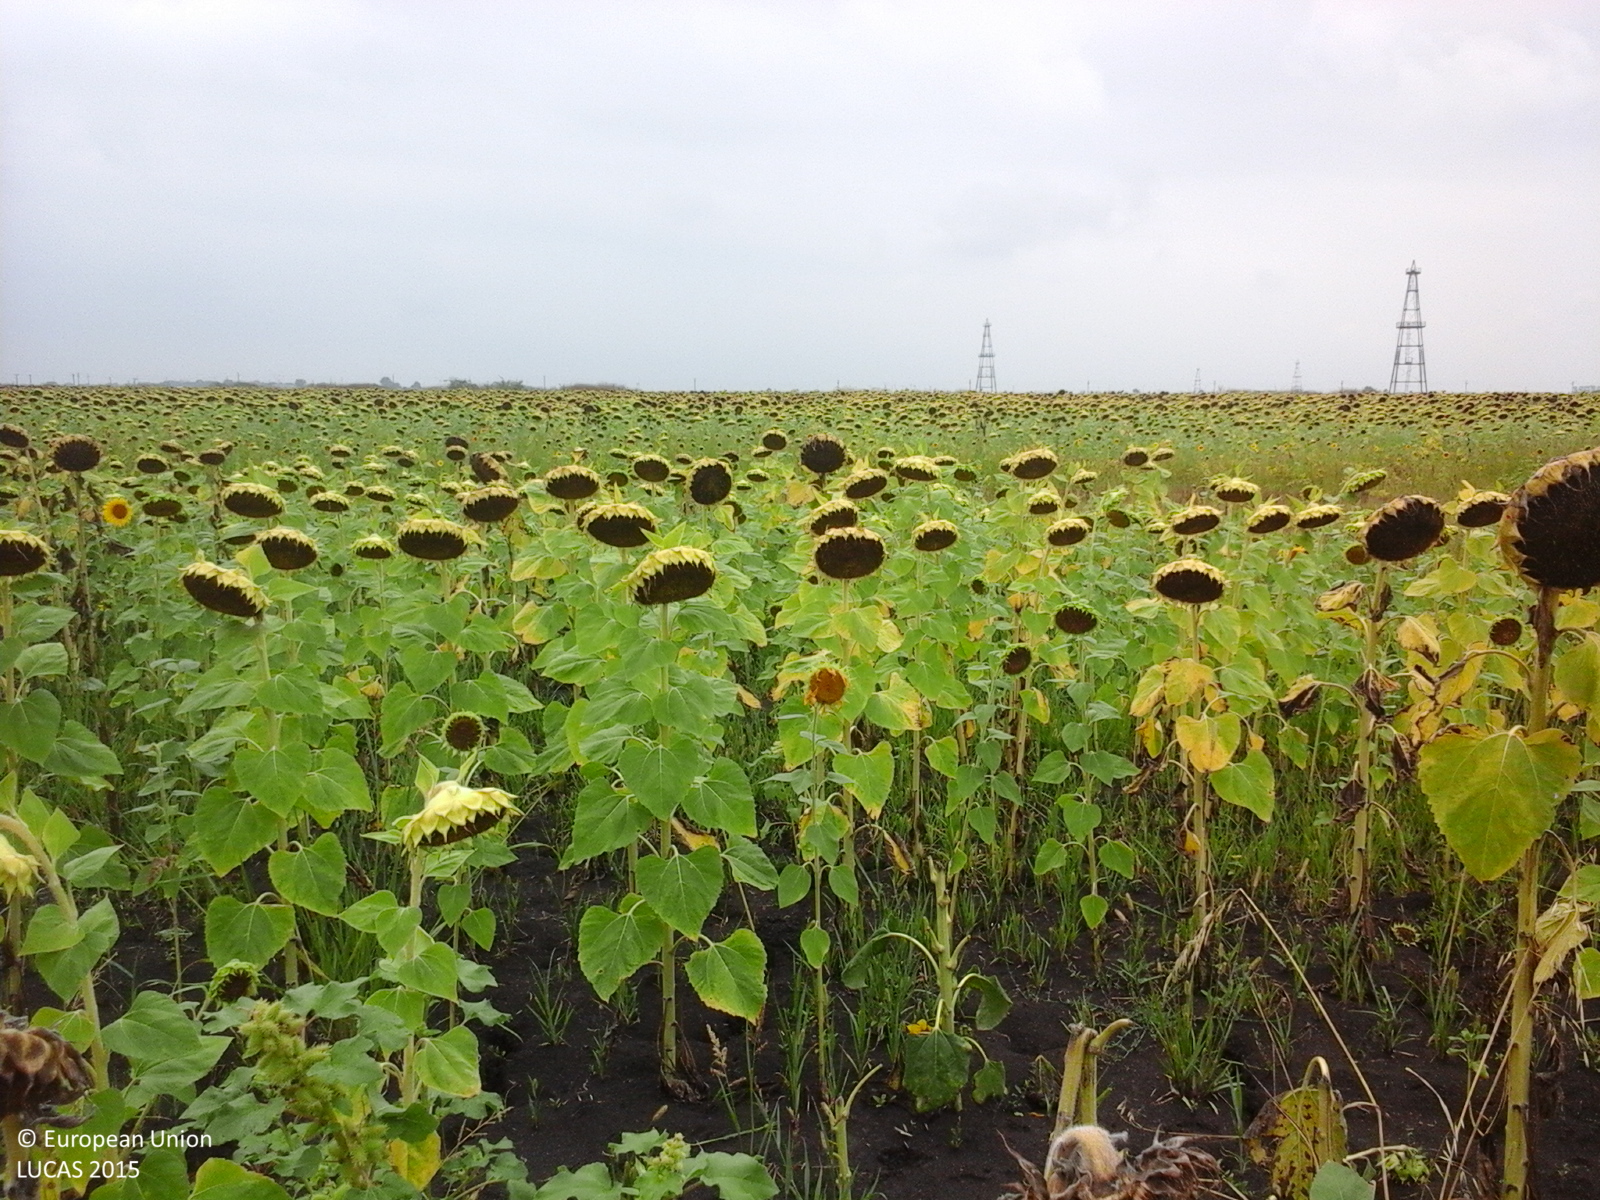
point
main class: Cropland
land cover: Sunflower
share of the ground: > 75 %
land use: Agriculture (excluding fallow land and kitchen gardens)
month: August
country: RO
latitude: 46.1316
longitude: 20.4173
